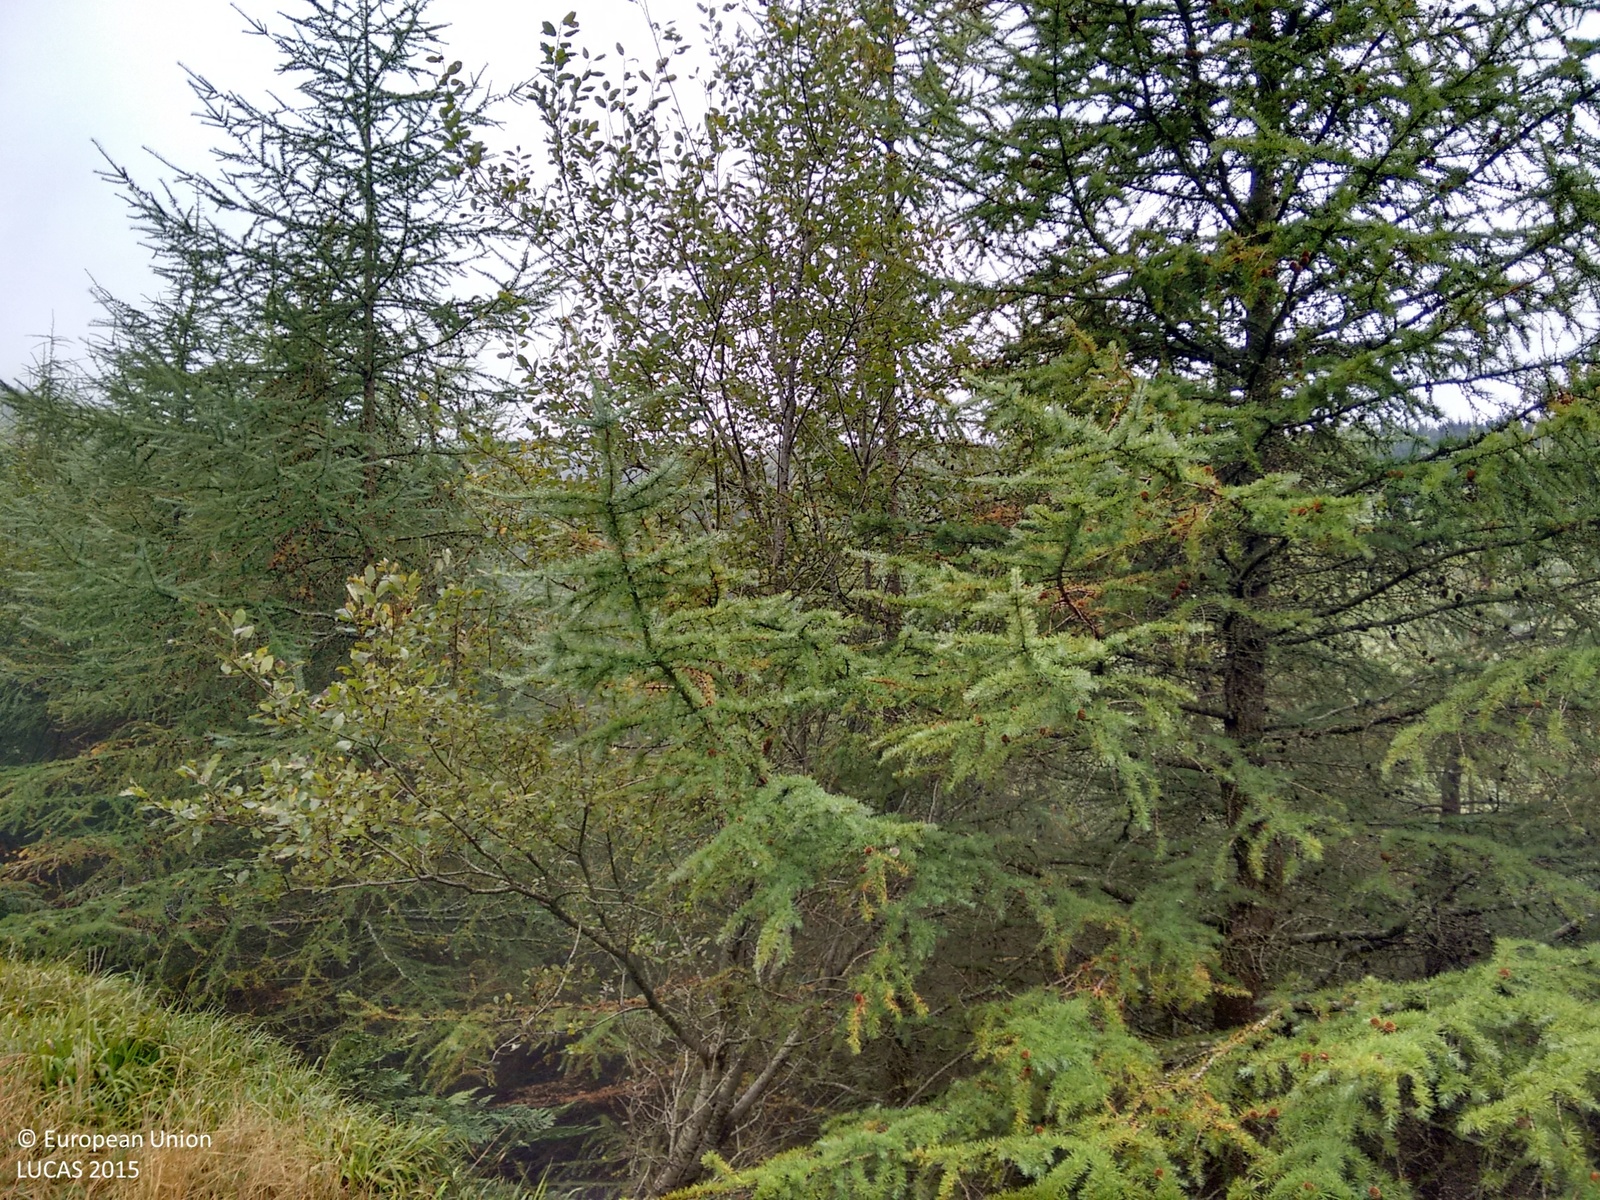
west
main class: Woodland
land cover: Pine dominated coniferous woodland
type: exotic forest
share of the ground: > 75 %
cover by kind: coniferous forest trees 80 %, shrubs 20 %
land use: Forestry
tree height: > 5 m
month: October
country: GB
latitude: 52.2779
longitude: -3.1667
